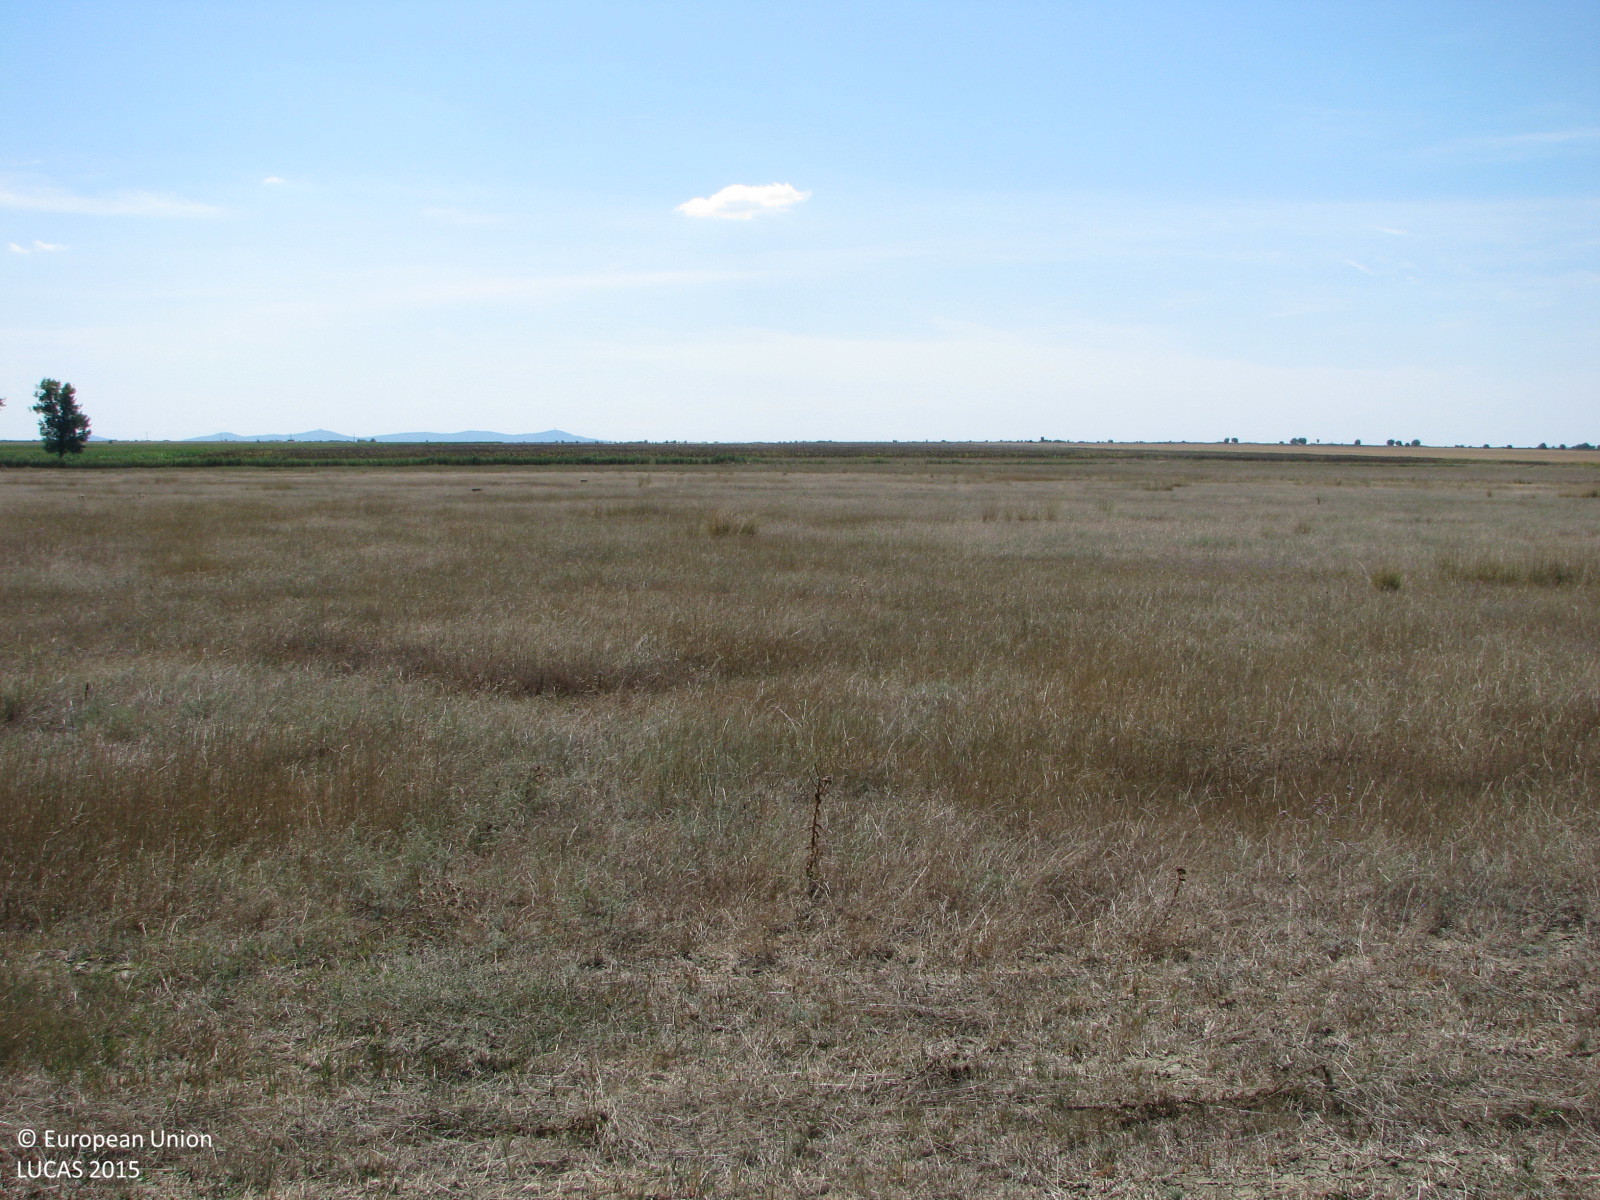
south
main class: Grassland
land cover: Grassland without tree/shrub cover
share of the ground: > 75 %
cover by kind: herbaceous plants 100 %
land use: Agriculture (excluding fallow land and kitchen gardens)
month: September
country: BG
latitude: 42.6174
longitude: 26.5909
